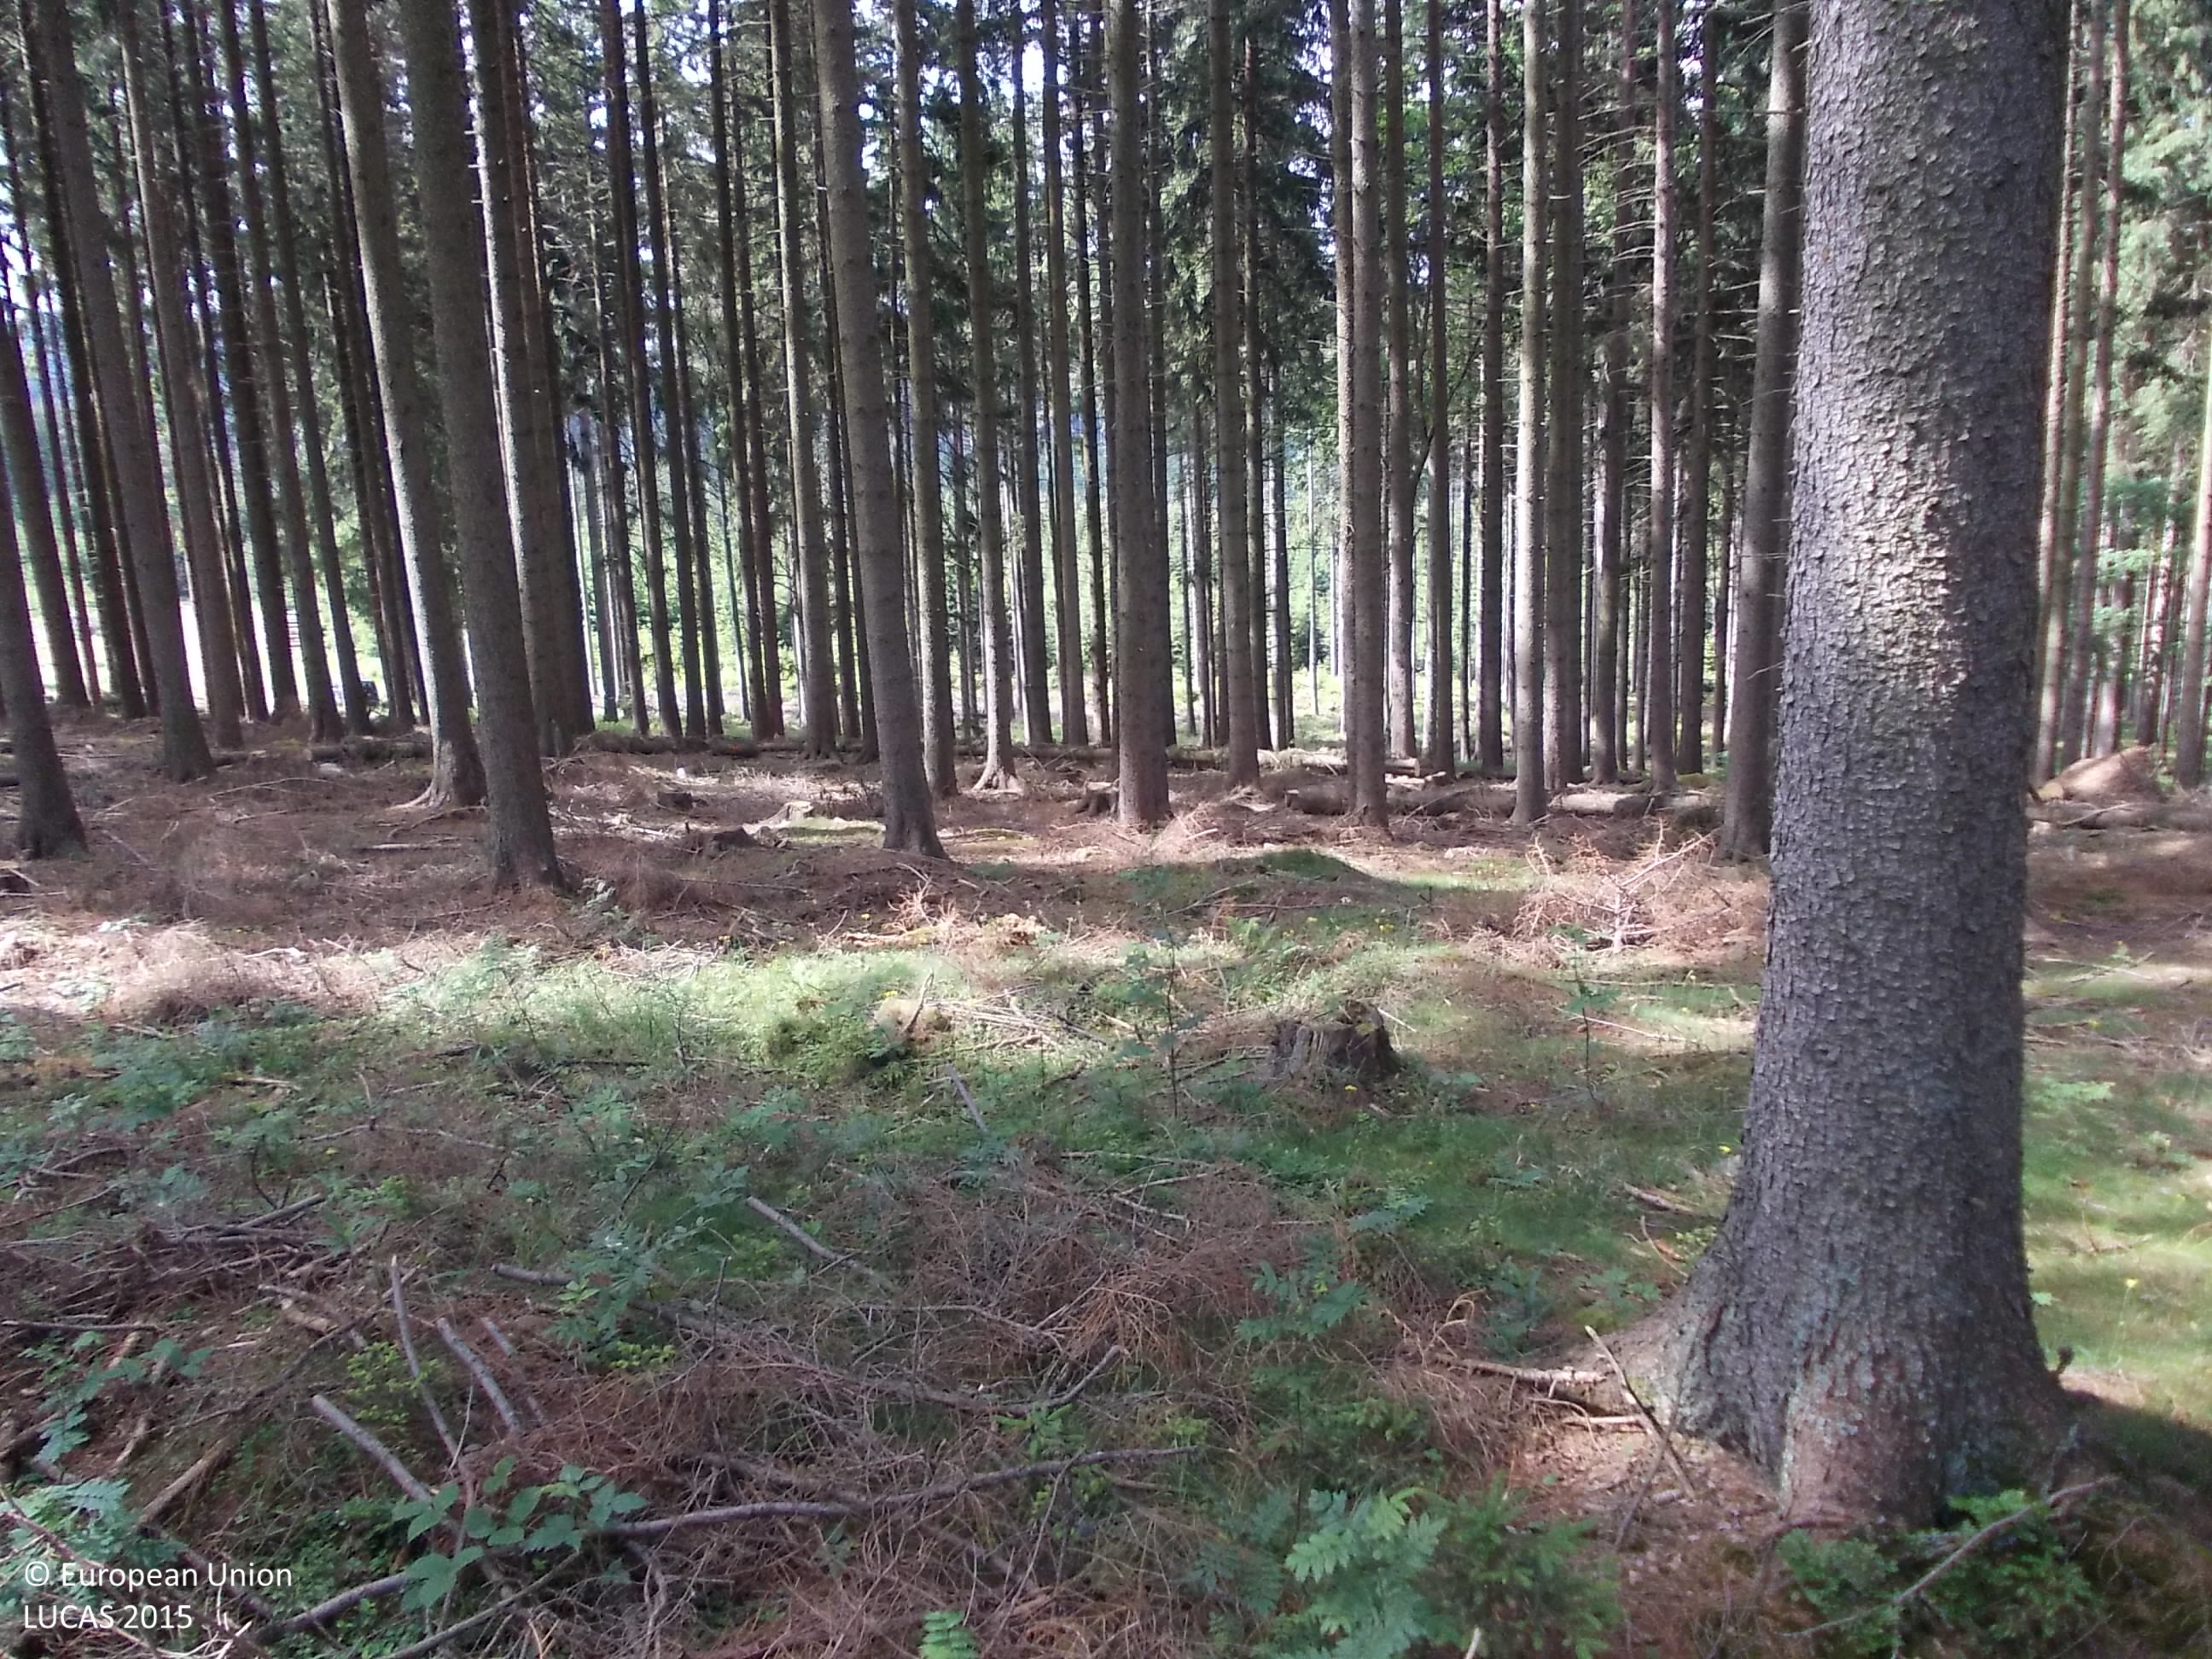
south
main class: Woodland
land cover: Spruce dominated coniferous woodland
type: hemiboreal forest and nemoral coniferous forest and mixed broadleaved-coniferous forest
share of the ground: > 75 %
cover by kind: coniferous forest trees 80 %, consolidated bare surface 10 %, herbaceous plants 5 %, lichens and mosses 5 %
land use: Forestry
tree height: > 5 m
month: June
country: CZ
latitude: 49.0437
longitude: 13.7076
